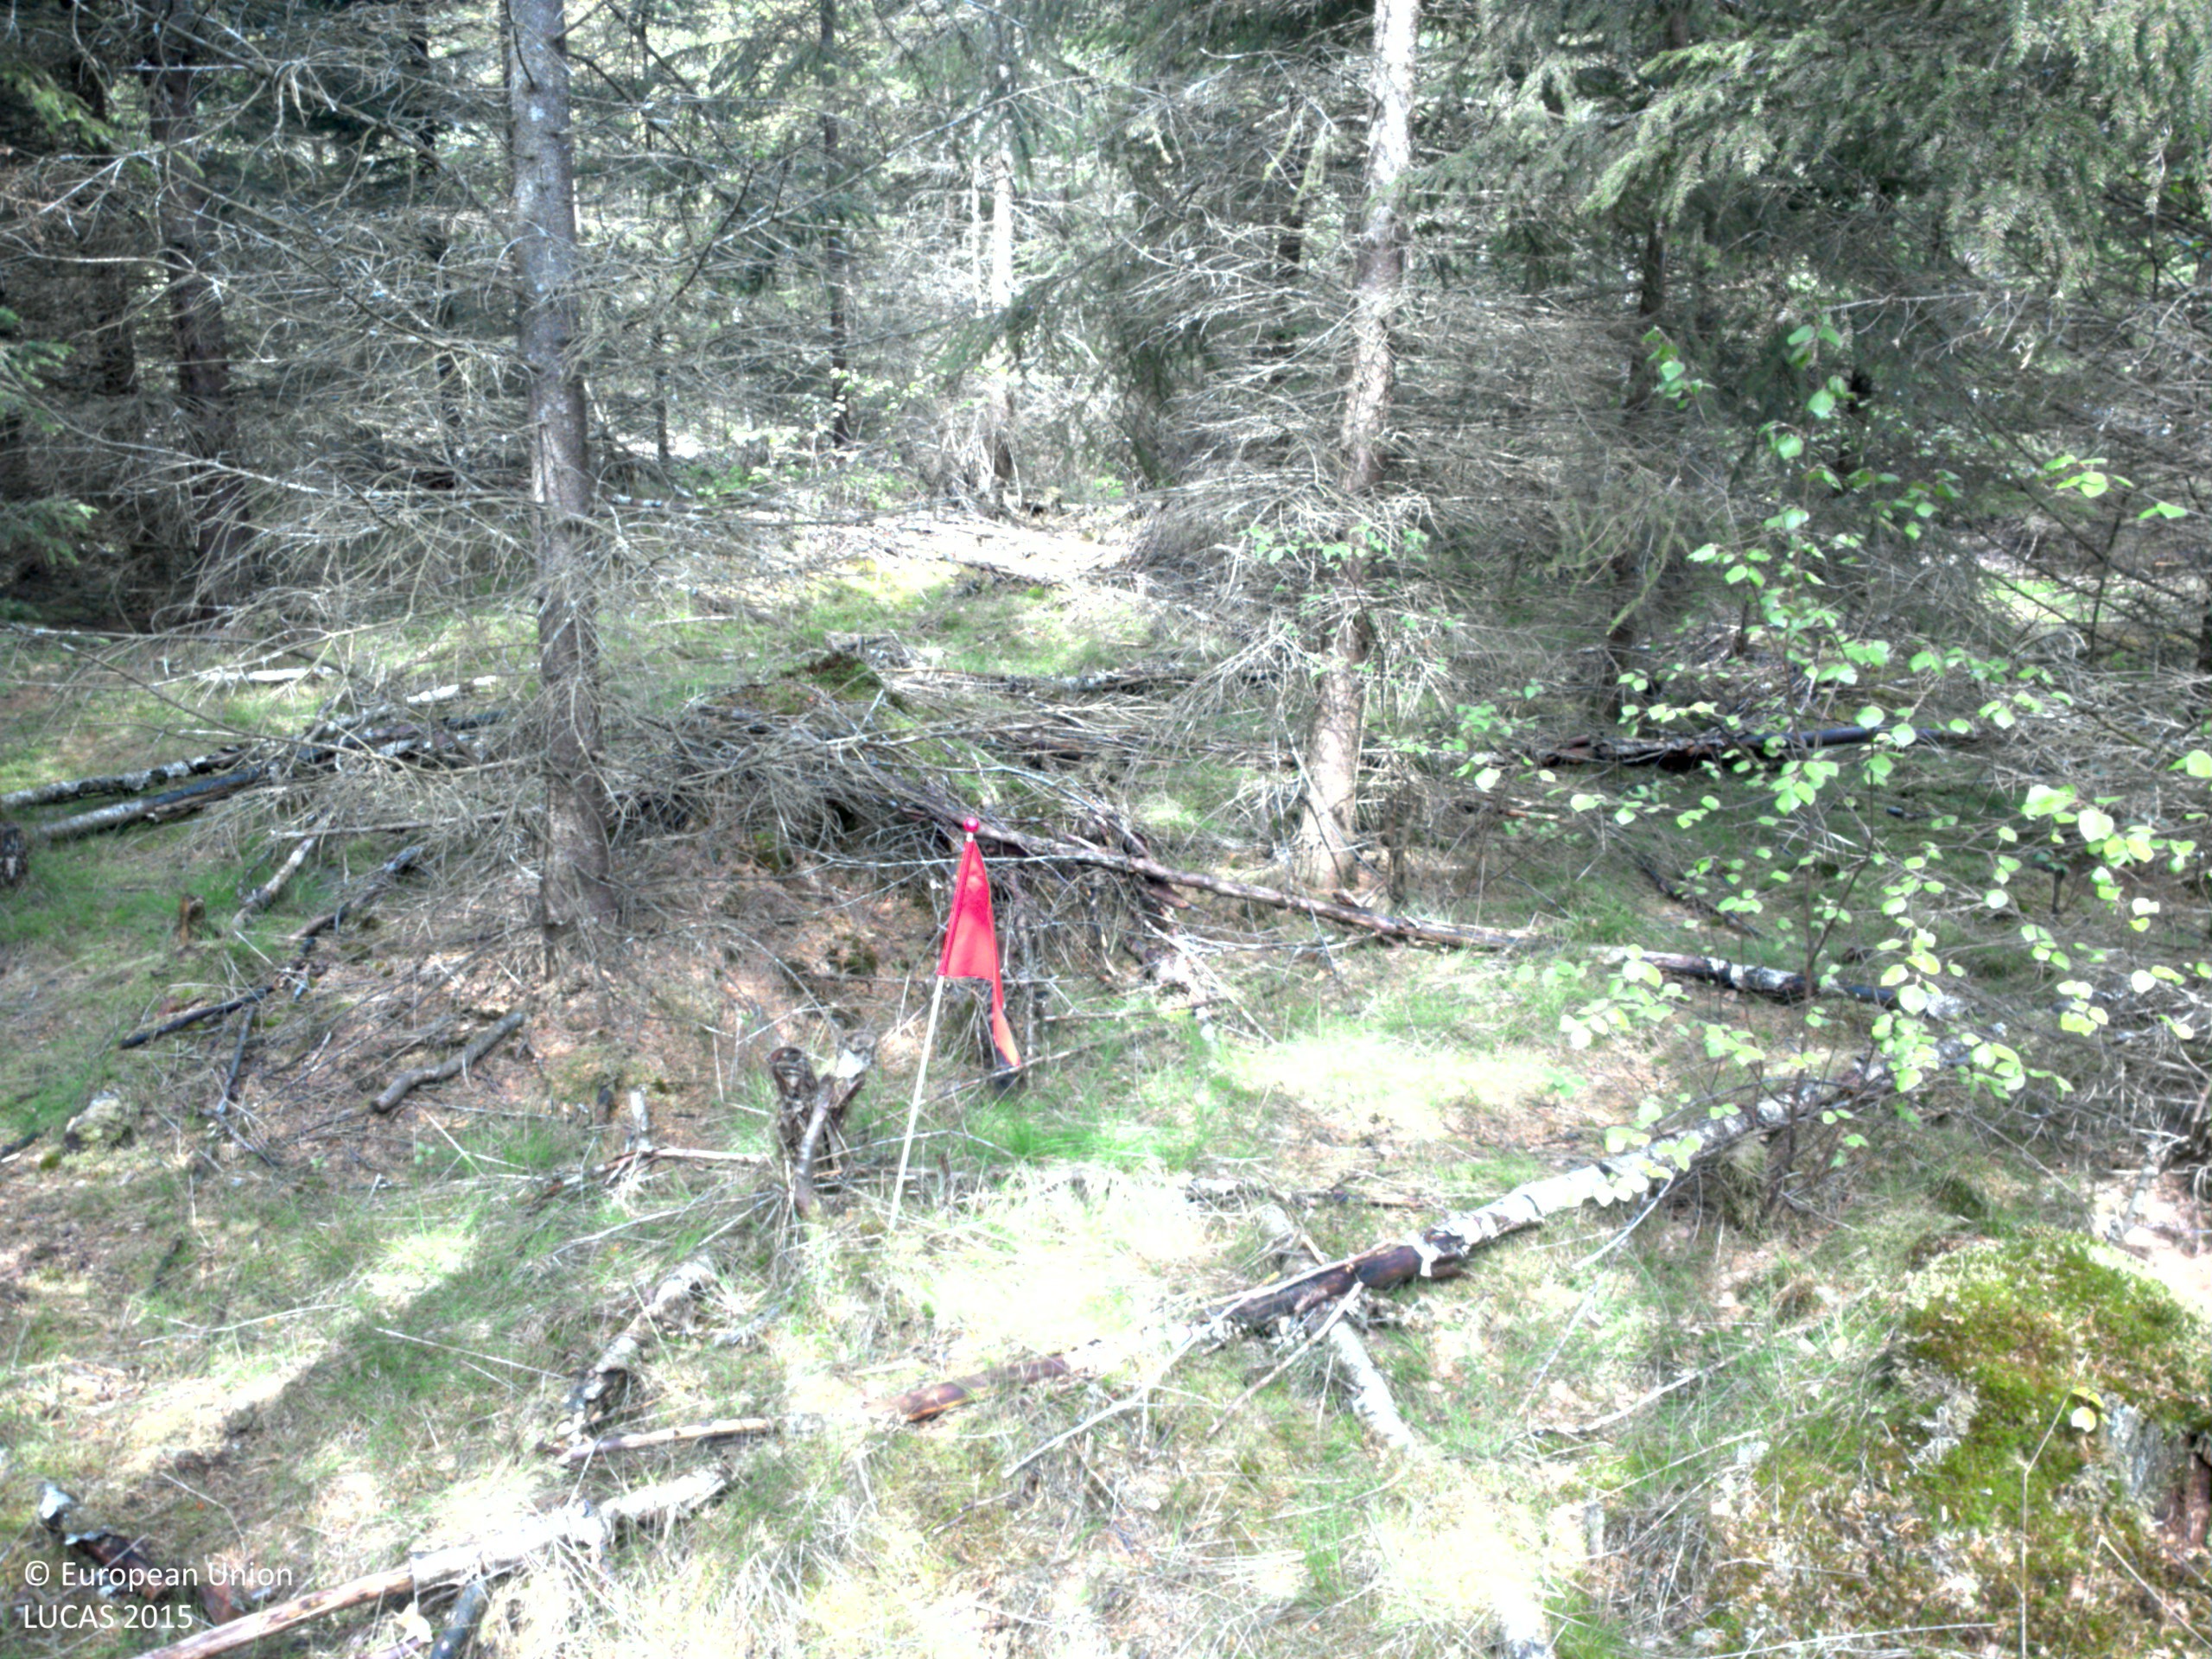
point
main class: Woodland
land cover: Spruce dominated coniferous woodland
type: boreal forest
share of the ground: > 75 %
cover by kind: coniferous forest trees 90 %, lichens and mosses 10 %
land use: Forestry
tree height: > 5 m
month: May
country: SE
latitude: 57.7338
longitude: 12.1965
